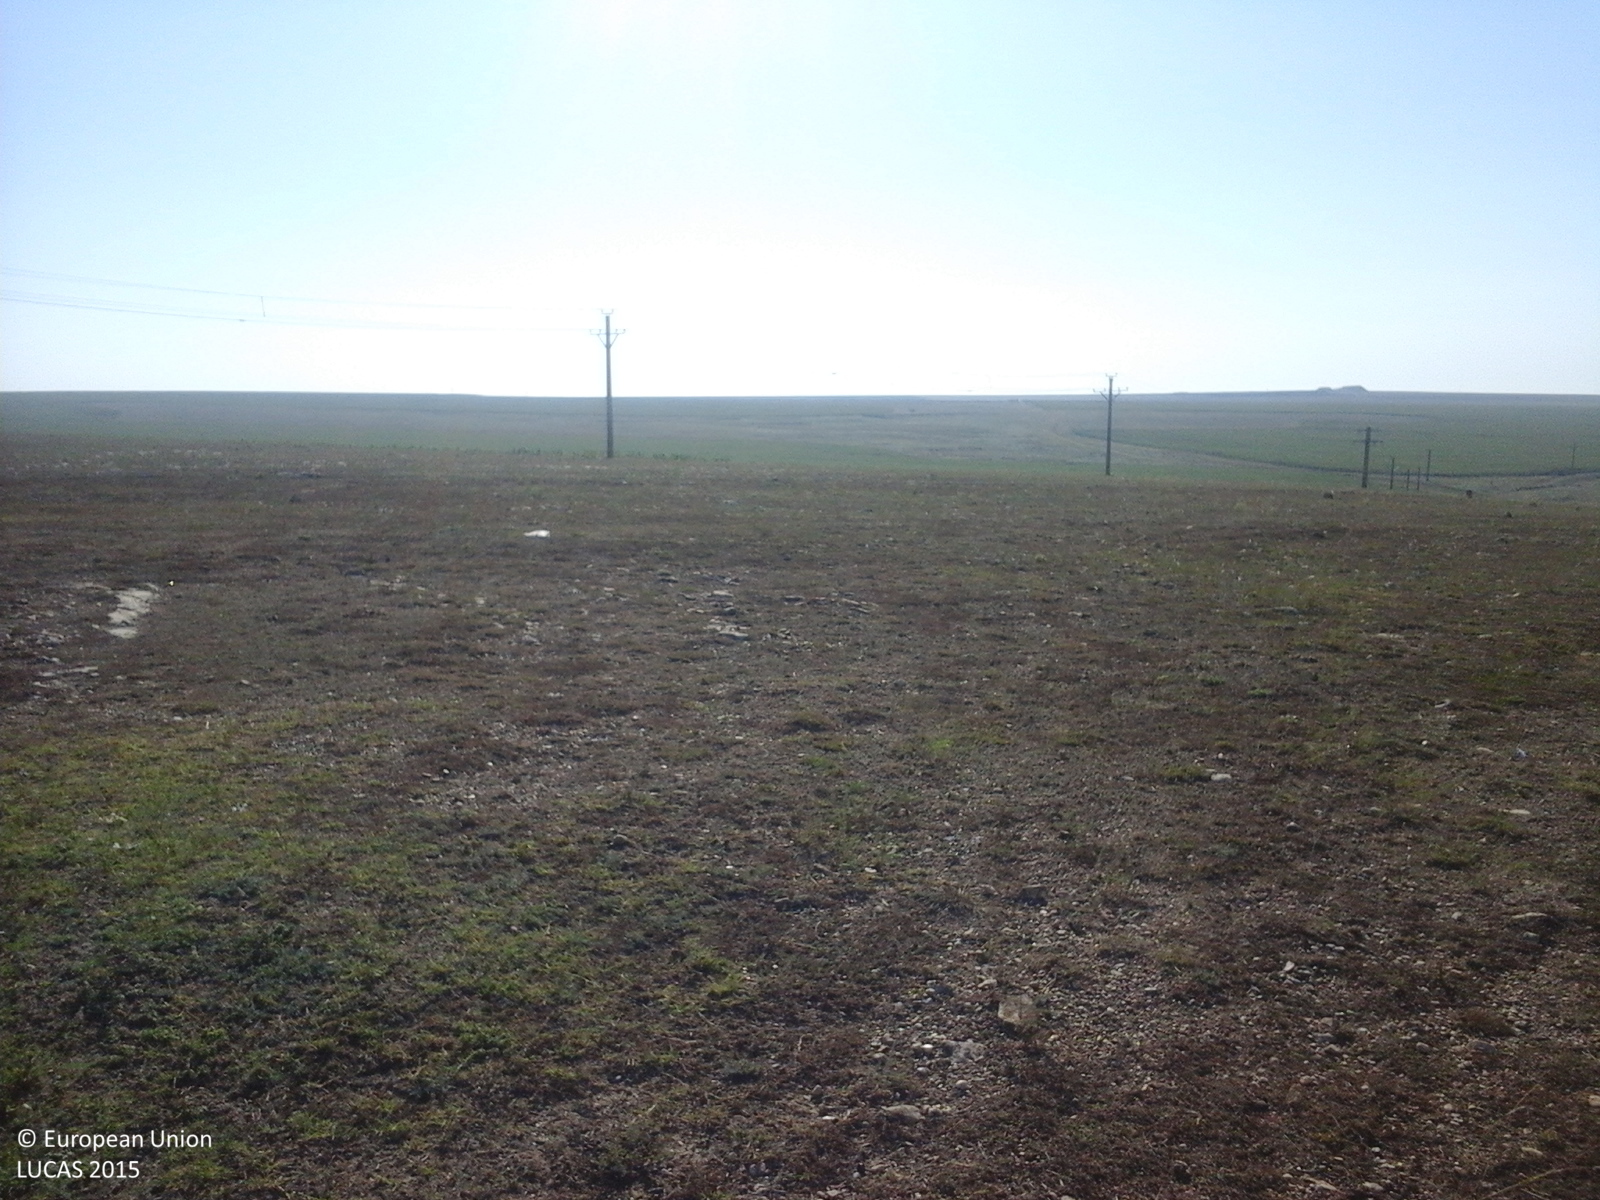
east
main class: Grassland
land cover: Grassland without tree/shrub cover
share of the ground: > 75 %
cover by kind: herbaceous plants 100 %
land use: Agriculture (excluding fallow land and kitchen gardens)
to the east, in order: Grassland without tree/shrub cover; Electric lines; Grassland without tree/shrub cover; Sunflower
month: August
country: RO
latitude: 44.3930
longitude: 28.5663
